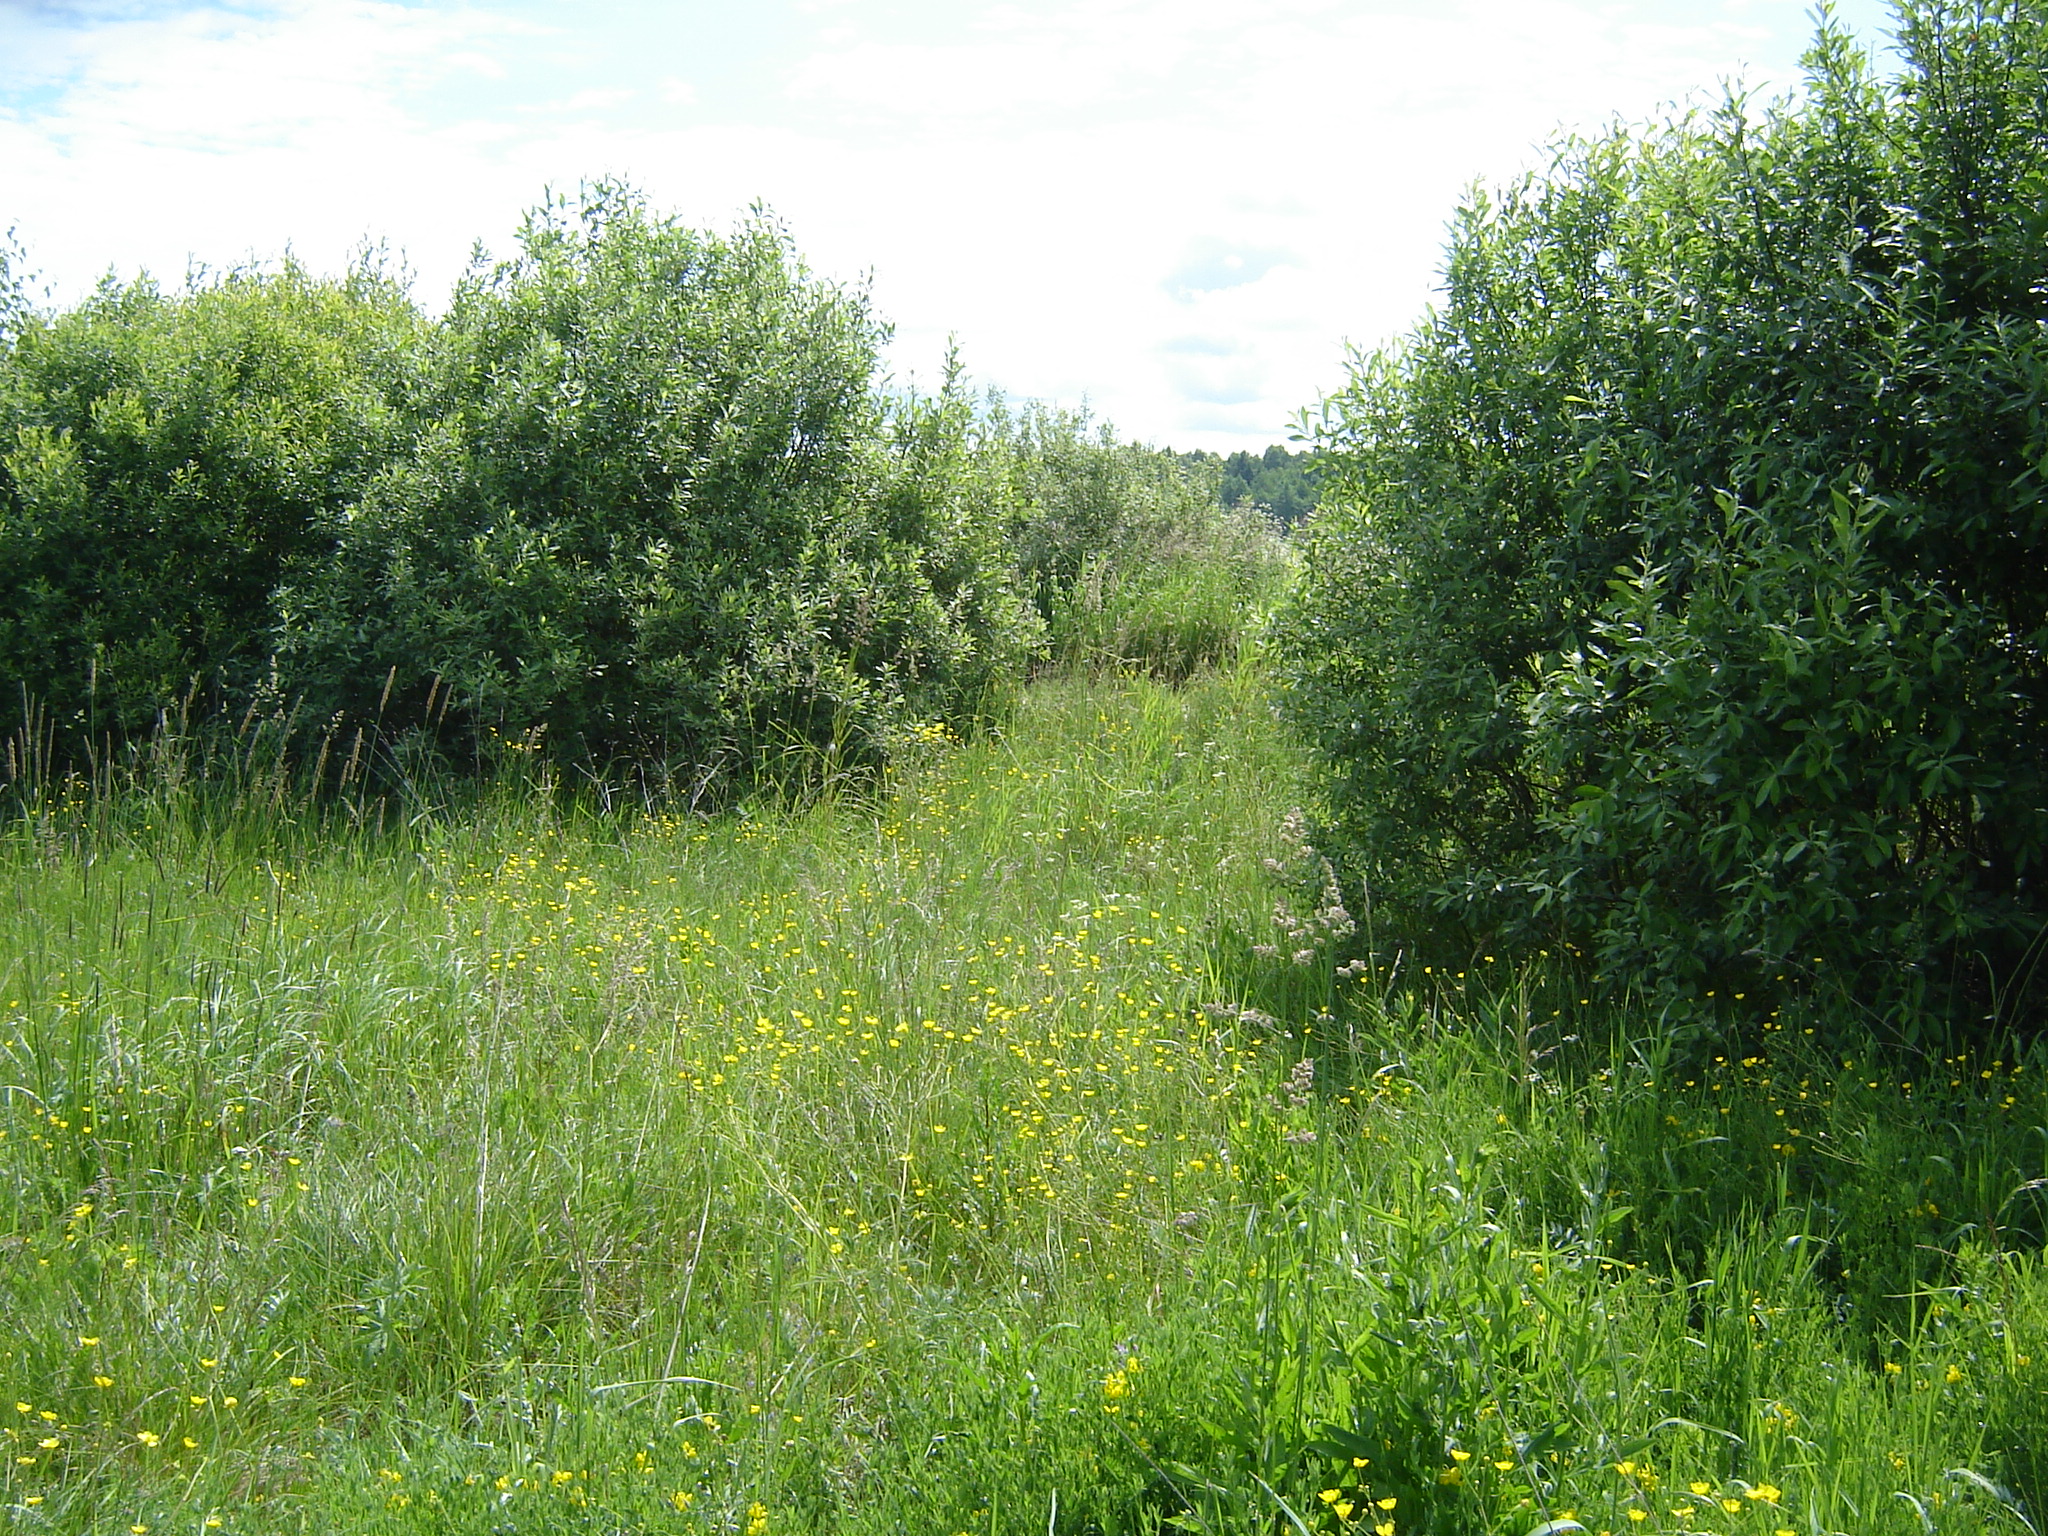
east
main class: Grassland
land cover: Spontaneously vegetated surfaces
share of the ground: > 75 %
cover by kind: herbaceous plants 100 %
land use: Fallow land
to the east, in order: Spontaneously vegetated surfaces; Abandoned hedges; Paved roads, cycling and walking lanes; Abandoned hedges; Spontaneously vegetated surfaces; Oats; Spontaneously vegetated surfaces; Broadleaved woodland
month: June
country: LT
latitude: 55.2247
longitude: 26.4546
